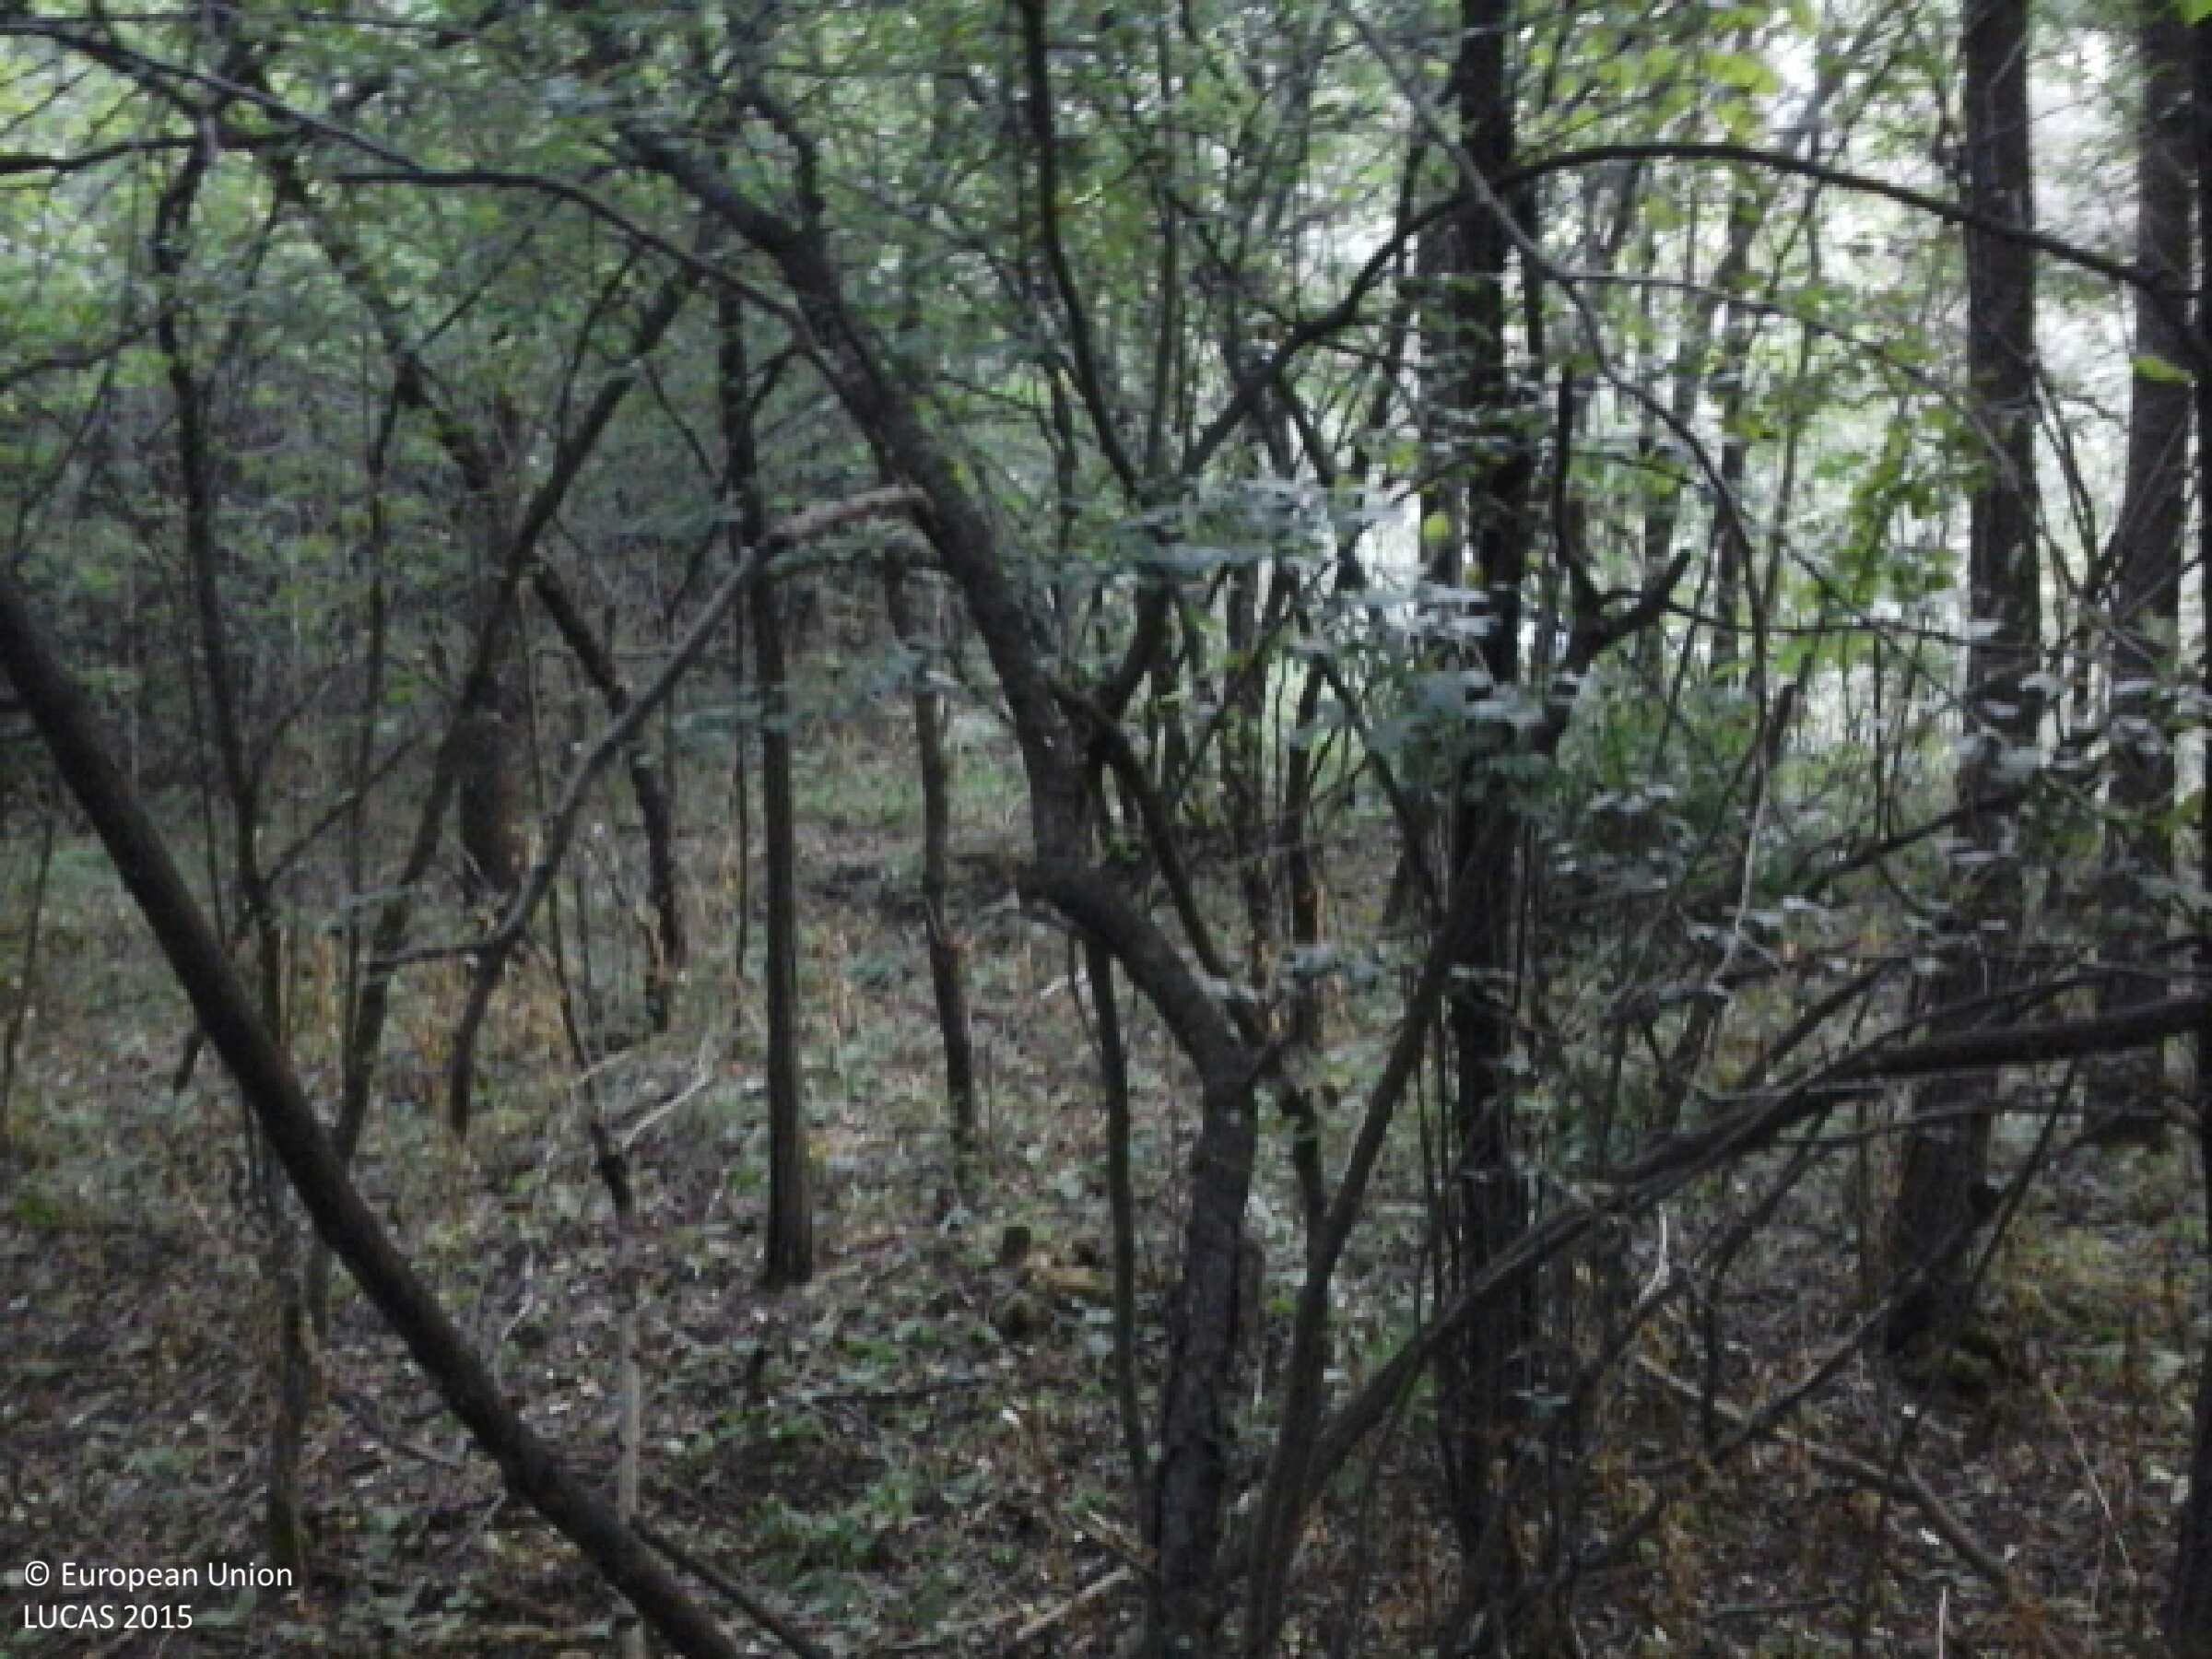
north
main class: Woodland
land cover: Broadleaved woodland
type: mesophytic deciduous forest
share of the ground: > 75 %
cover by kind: broadleaved forest trees 95 %, herbaceous plants 5 %
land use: Forestry
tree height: > 5 m
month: August
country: HU
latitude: 47.7298
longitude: 18.0518
